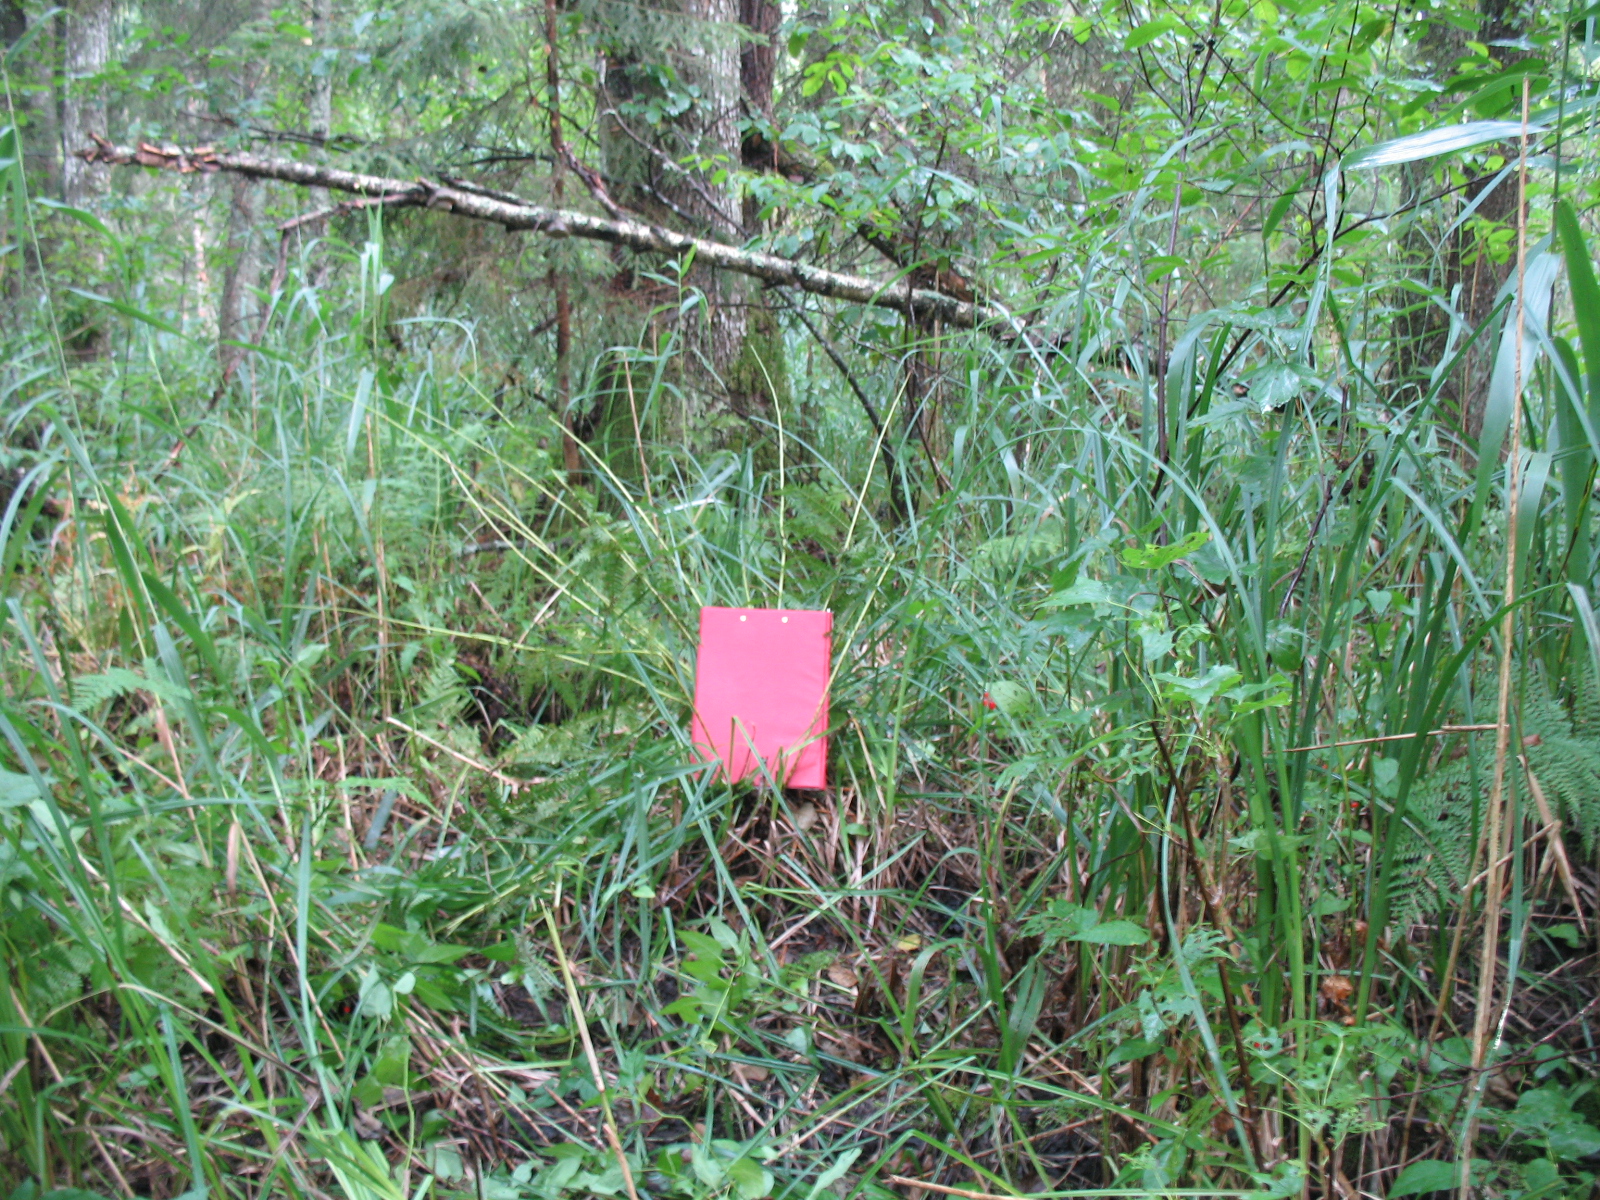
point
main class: Woodland
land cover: Broadleaved woodland
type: mire and swamp forests
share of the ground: > 75 %
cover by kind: broadleaved forest trees 75 %, herbaceous plants 15 %, coniferous forest trees 10 %
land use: Forestry
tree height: > 5 m
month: September
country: LV
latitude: 56.1601
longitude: 26.1937
